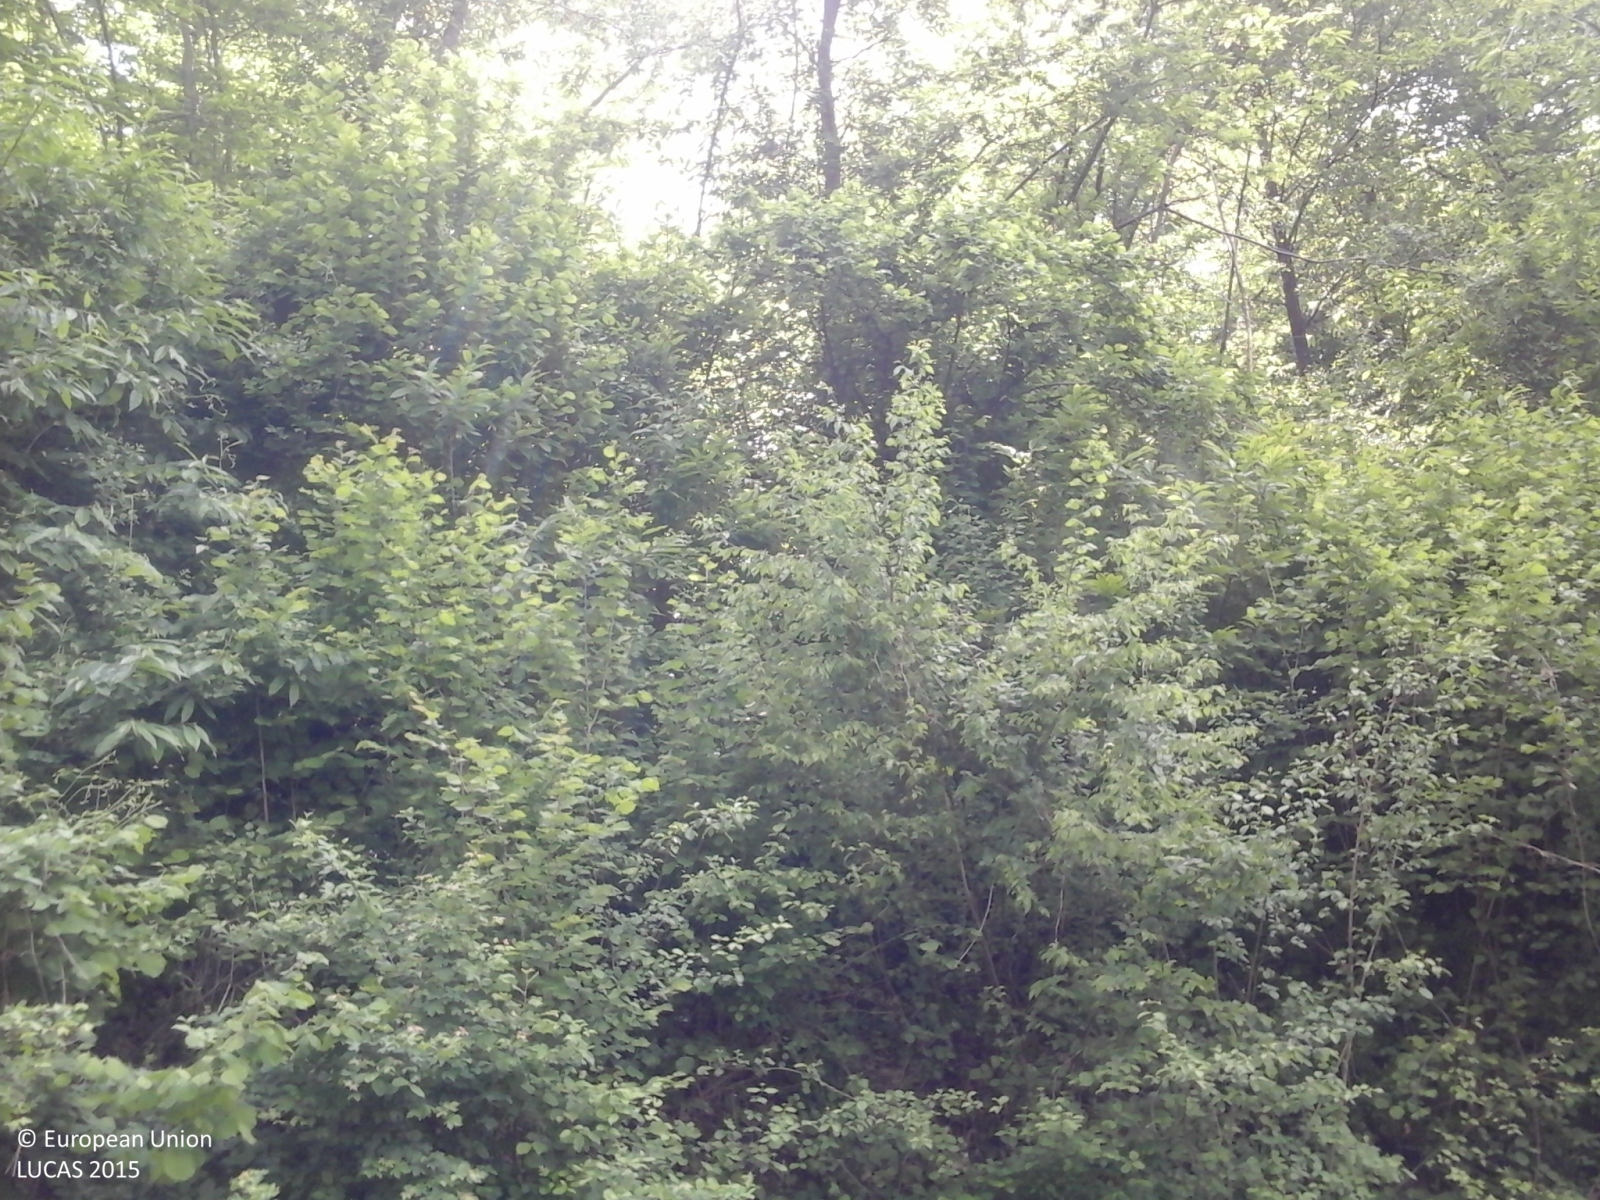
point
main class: Woodland
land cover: Broadleaved woodland
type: thermophilous deciduous forest
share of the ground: > 75 %
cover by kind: broadleaved forest trees 70 %, shrubs 30 %
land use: Forestry
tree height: > 5 m
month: May
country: IT
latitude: 44.4761
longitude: 9.6111
